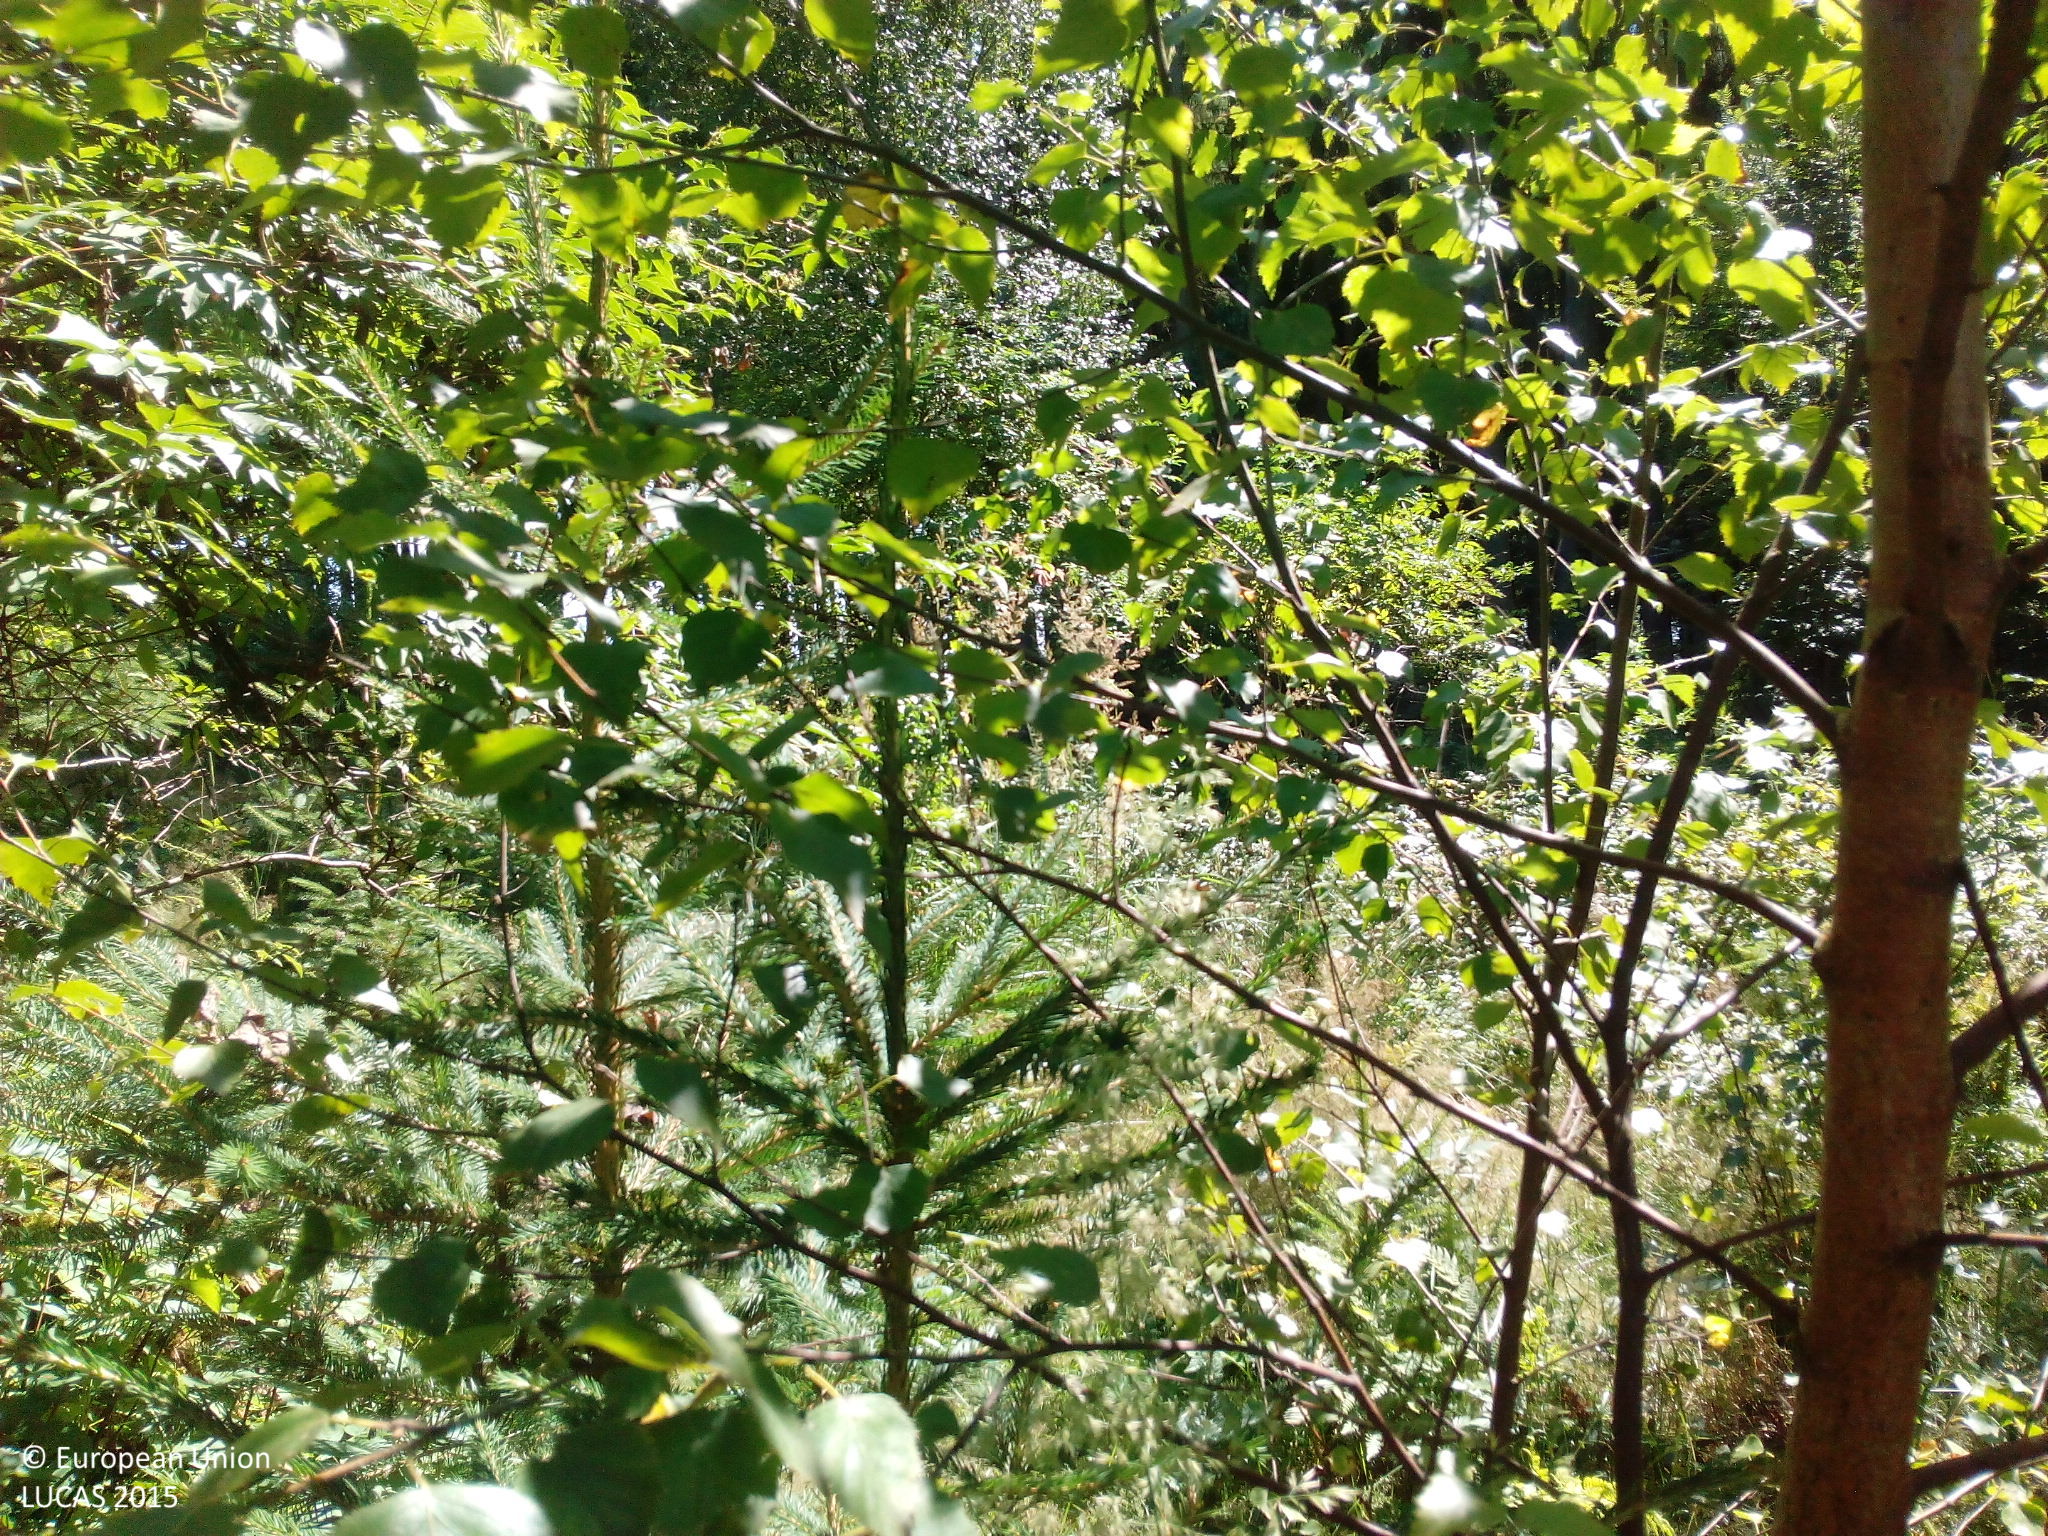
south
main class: Woodland
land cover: Spruce dominated coniferous woodland
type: hemiboreal forest and nemoral coniferous forest and mixed broadleaved-coniferous forest
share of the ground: > 75 %
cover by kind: coniferous forest trees 85 %, broadleaved forest trees 15 %
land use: Forestry
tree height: < 5 m
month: July
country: DE
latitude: 48.7093
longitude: 9.9593
